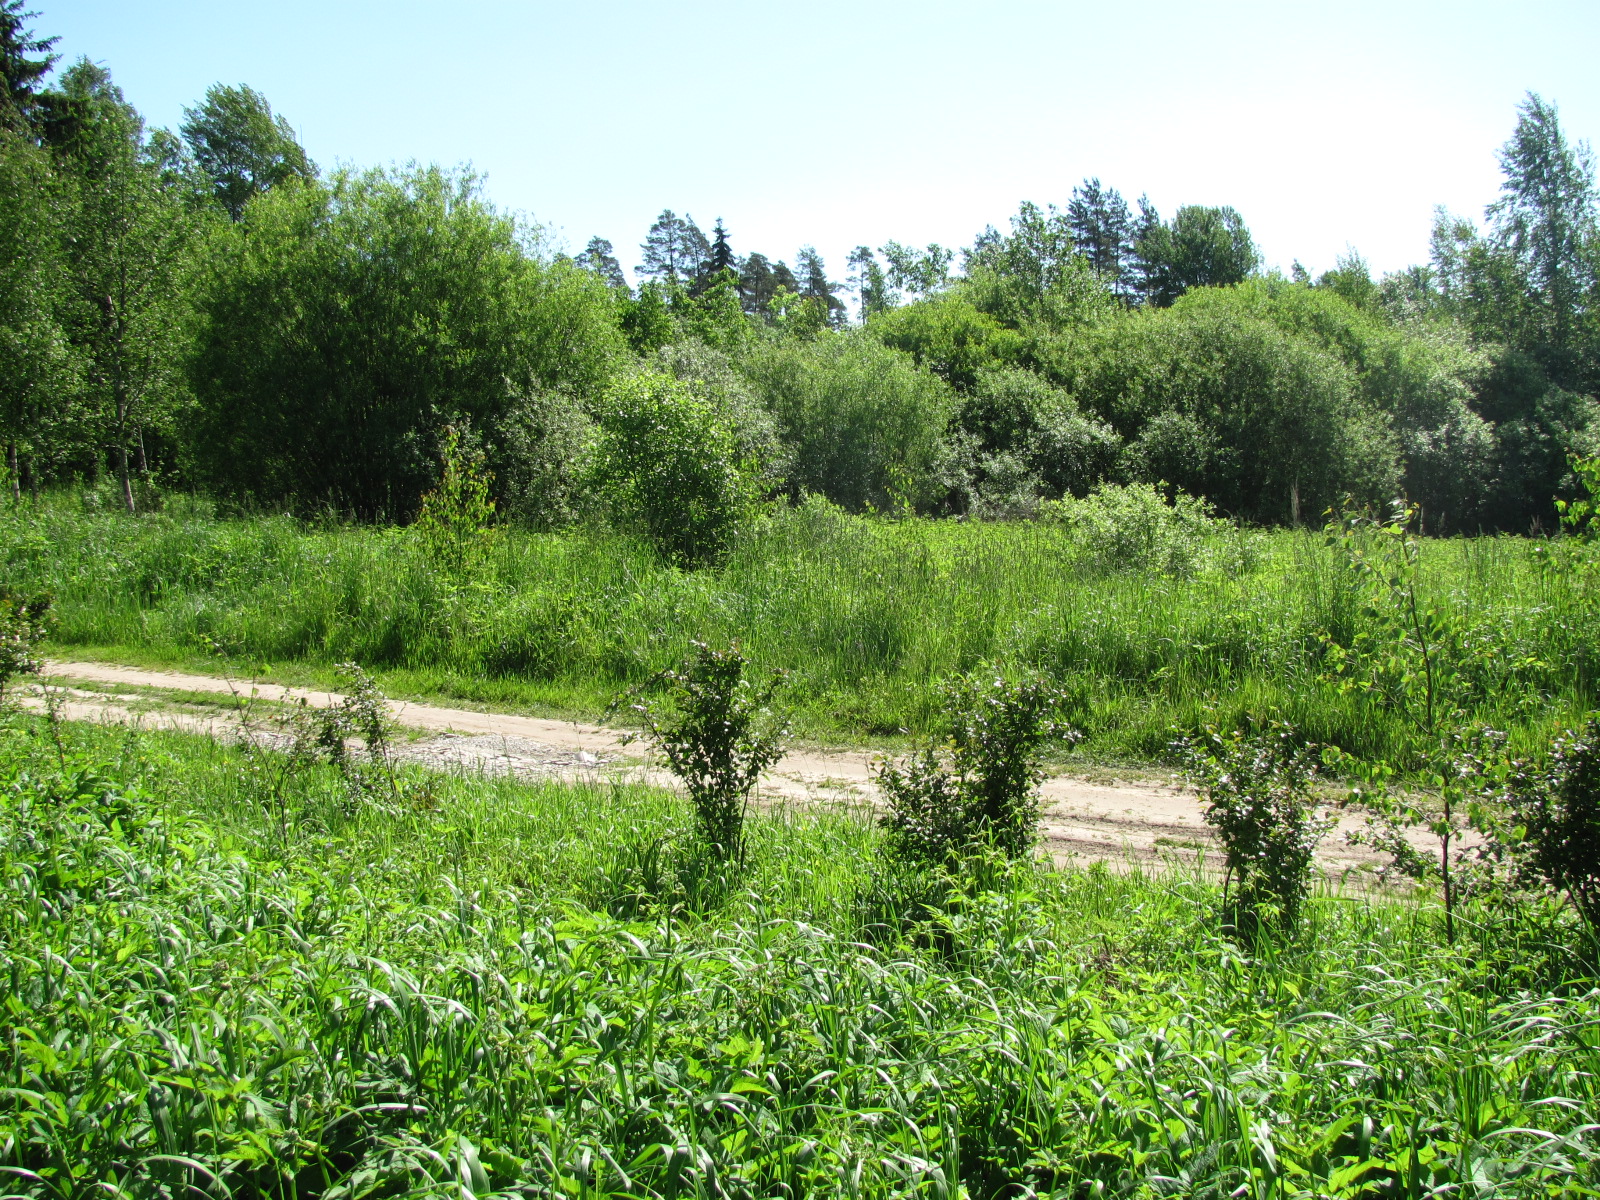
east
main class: Grassland
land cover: Grassland without tree/shrub cover
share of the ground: > 75 %
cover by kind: herbaceous plants 100 %
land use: Residential
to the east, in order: Grassland without tree/shrub cover; Grassland with sparse tree/shrub cover; Grass margins; Tracks; Grassland with sparse tree/shrub cover; Broadleaved woodland; Paved roads, cycling and walking lanes; Broadleaved woodland; Grassland without tree/shrub cover; Broadleaved woodland; Other mixed woodland
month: June
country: LV
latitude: 56.5493
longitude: 24.3250
